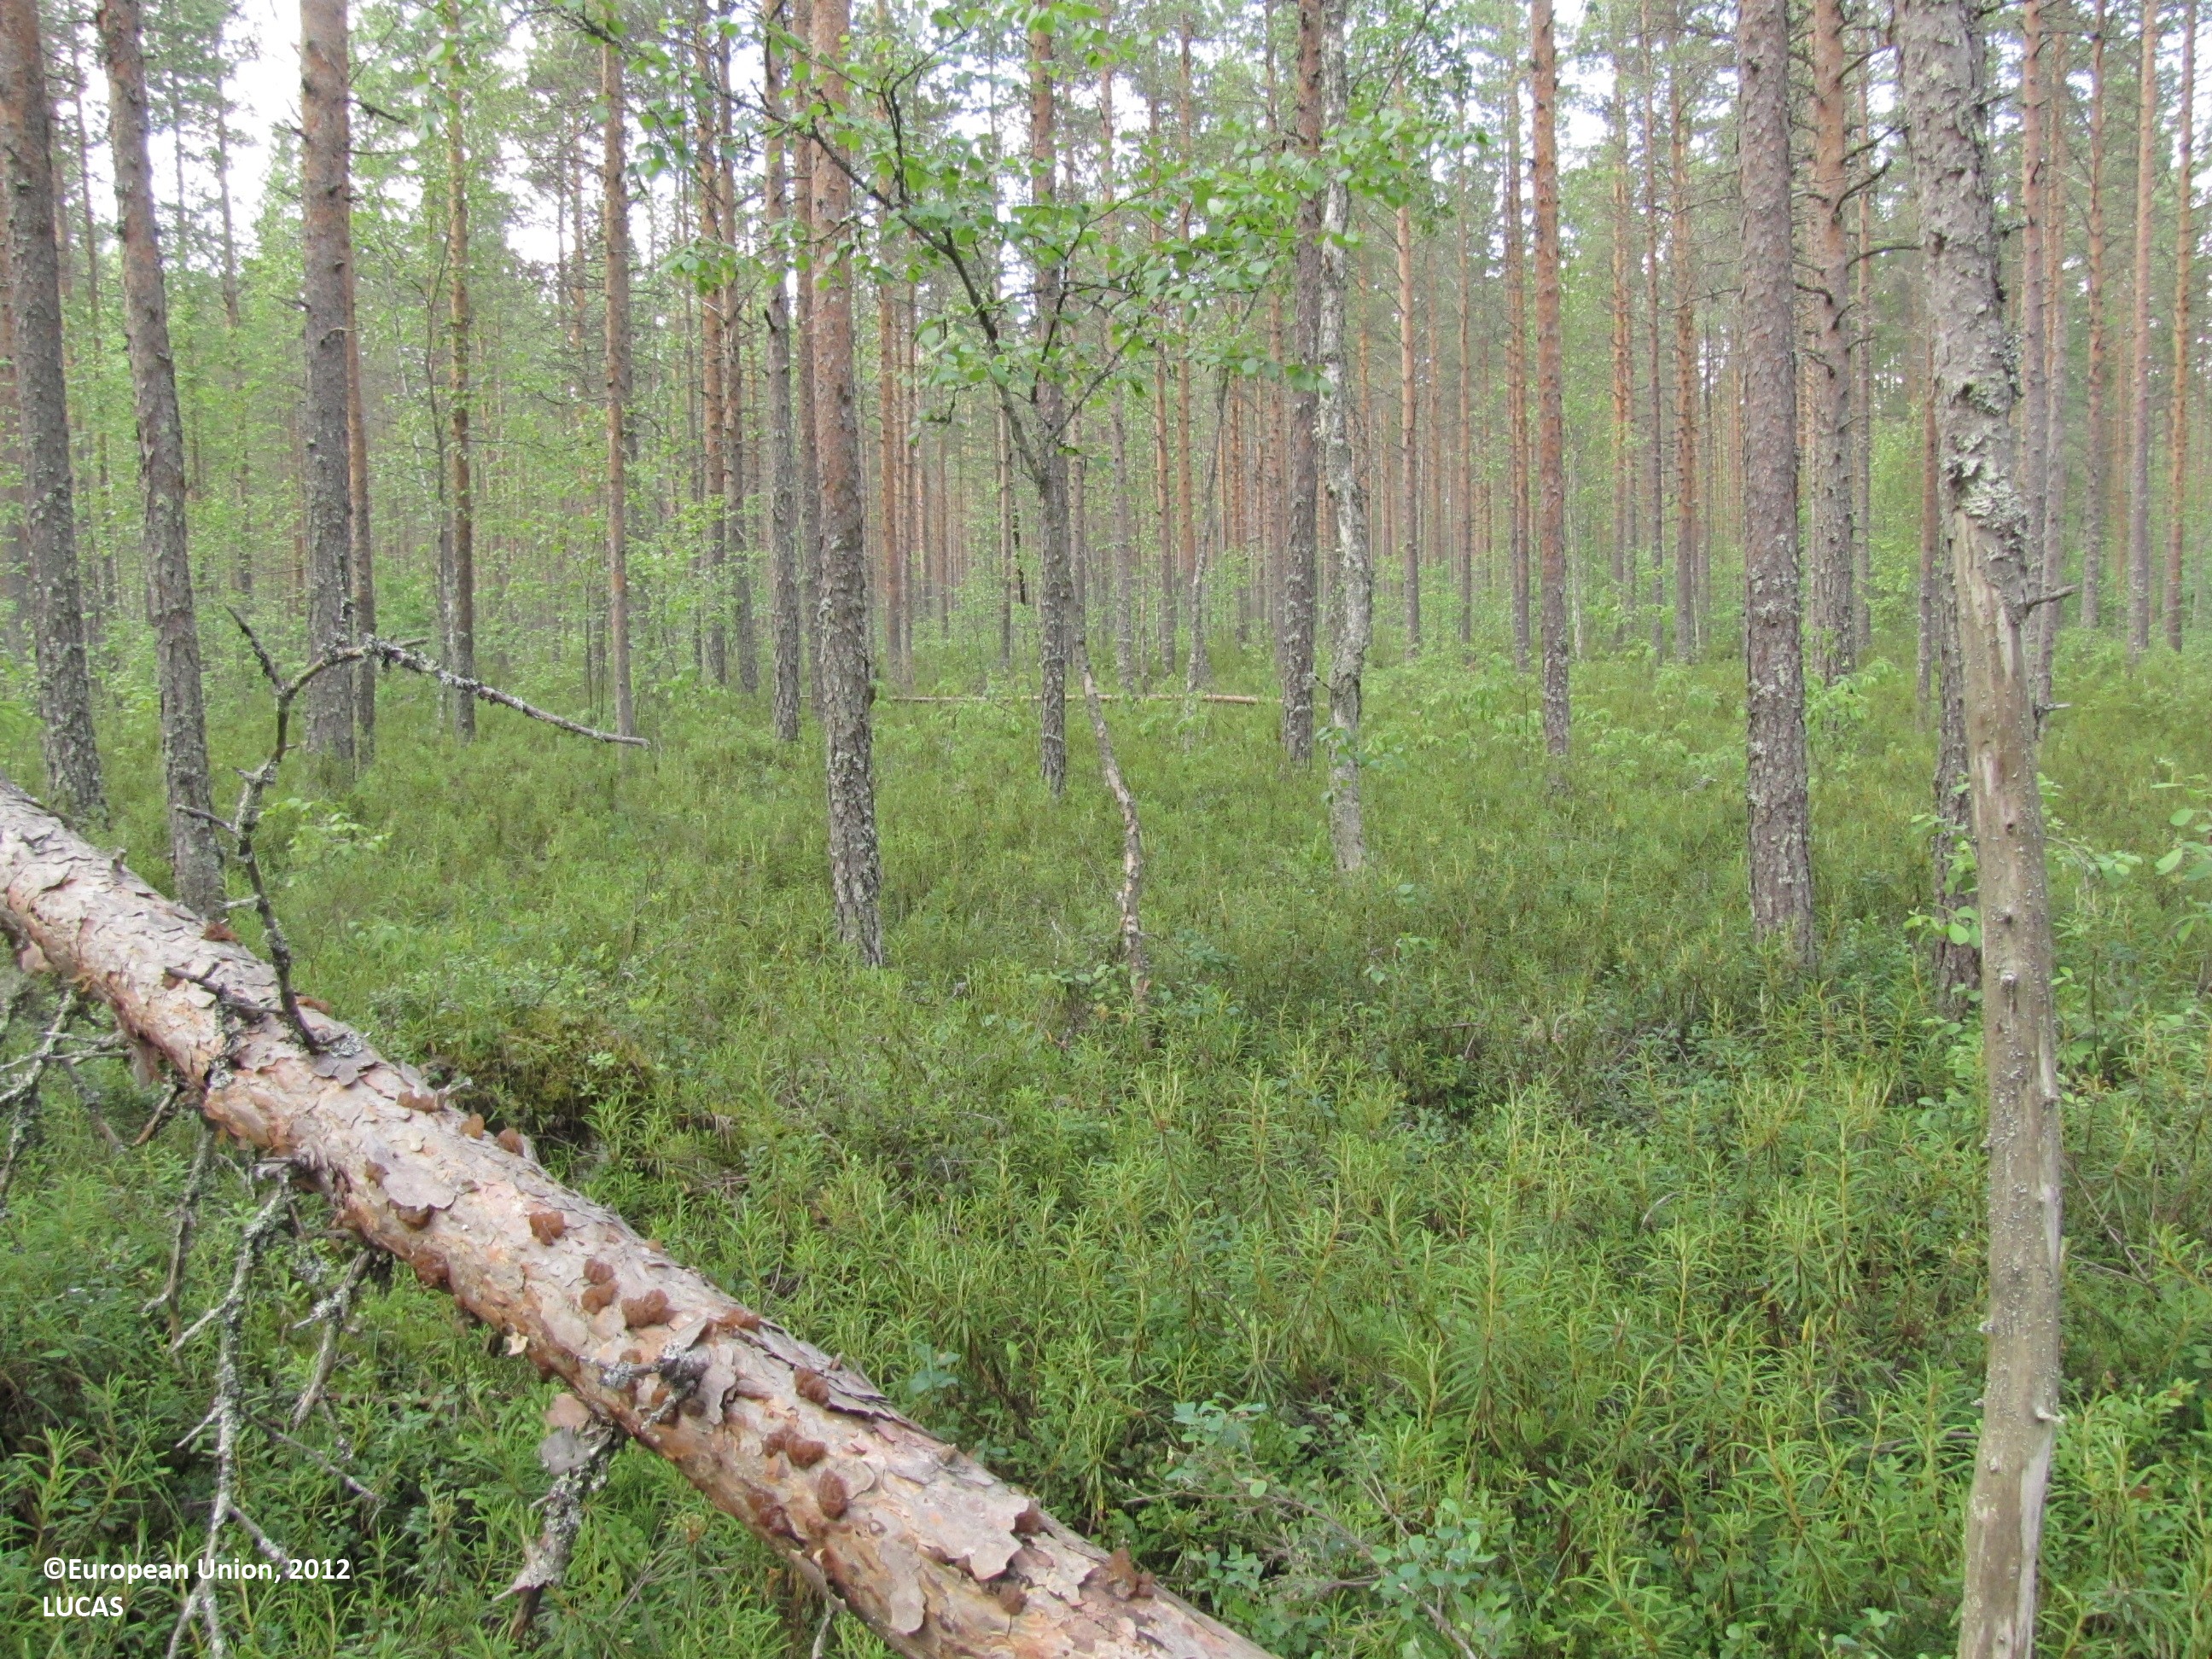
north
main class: Woodland
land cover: Pine dominated coniferous woodland
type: mire and swamp forests
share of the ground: 50 - 75 %
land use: Forestry
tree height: > 5 m
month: July
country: FI
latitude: 62.3672
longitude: 23.5044
